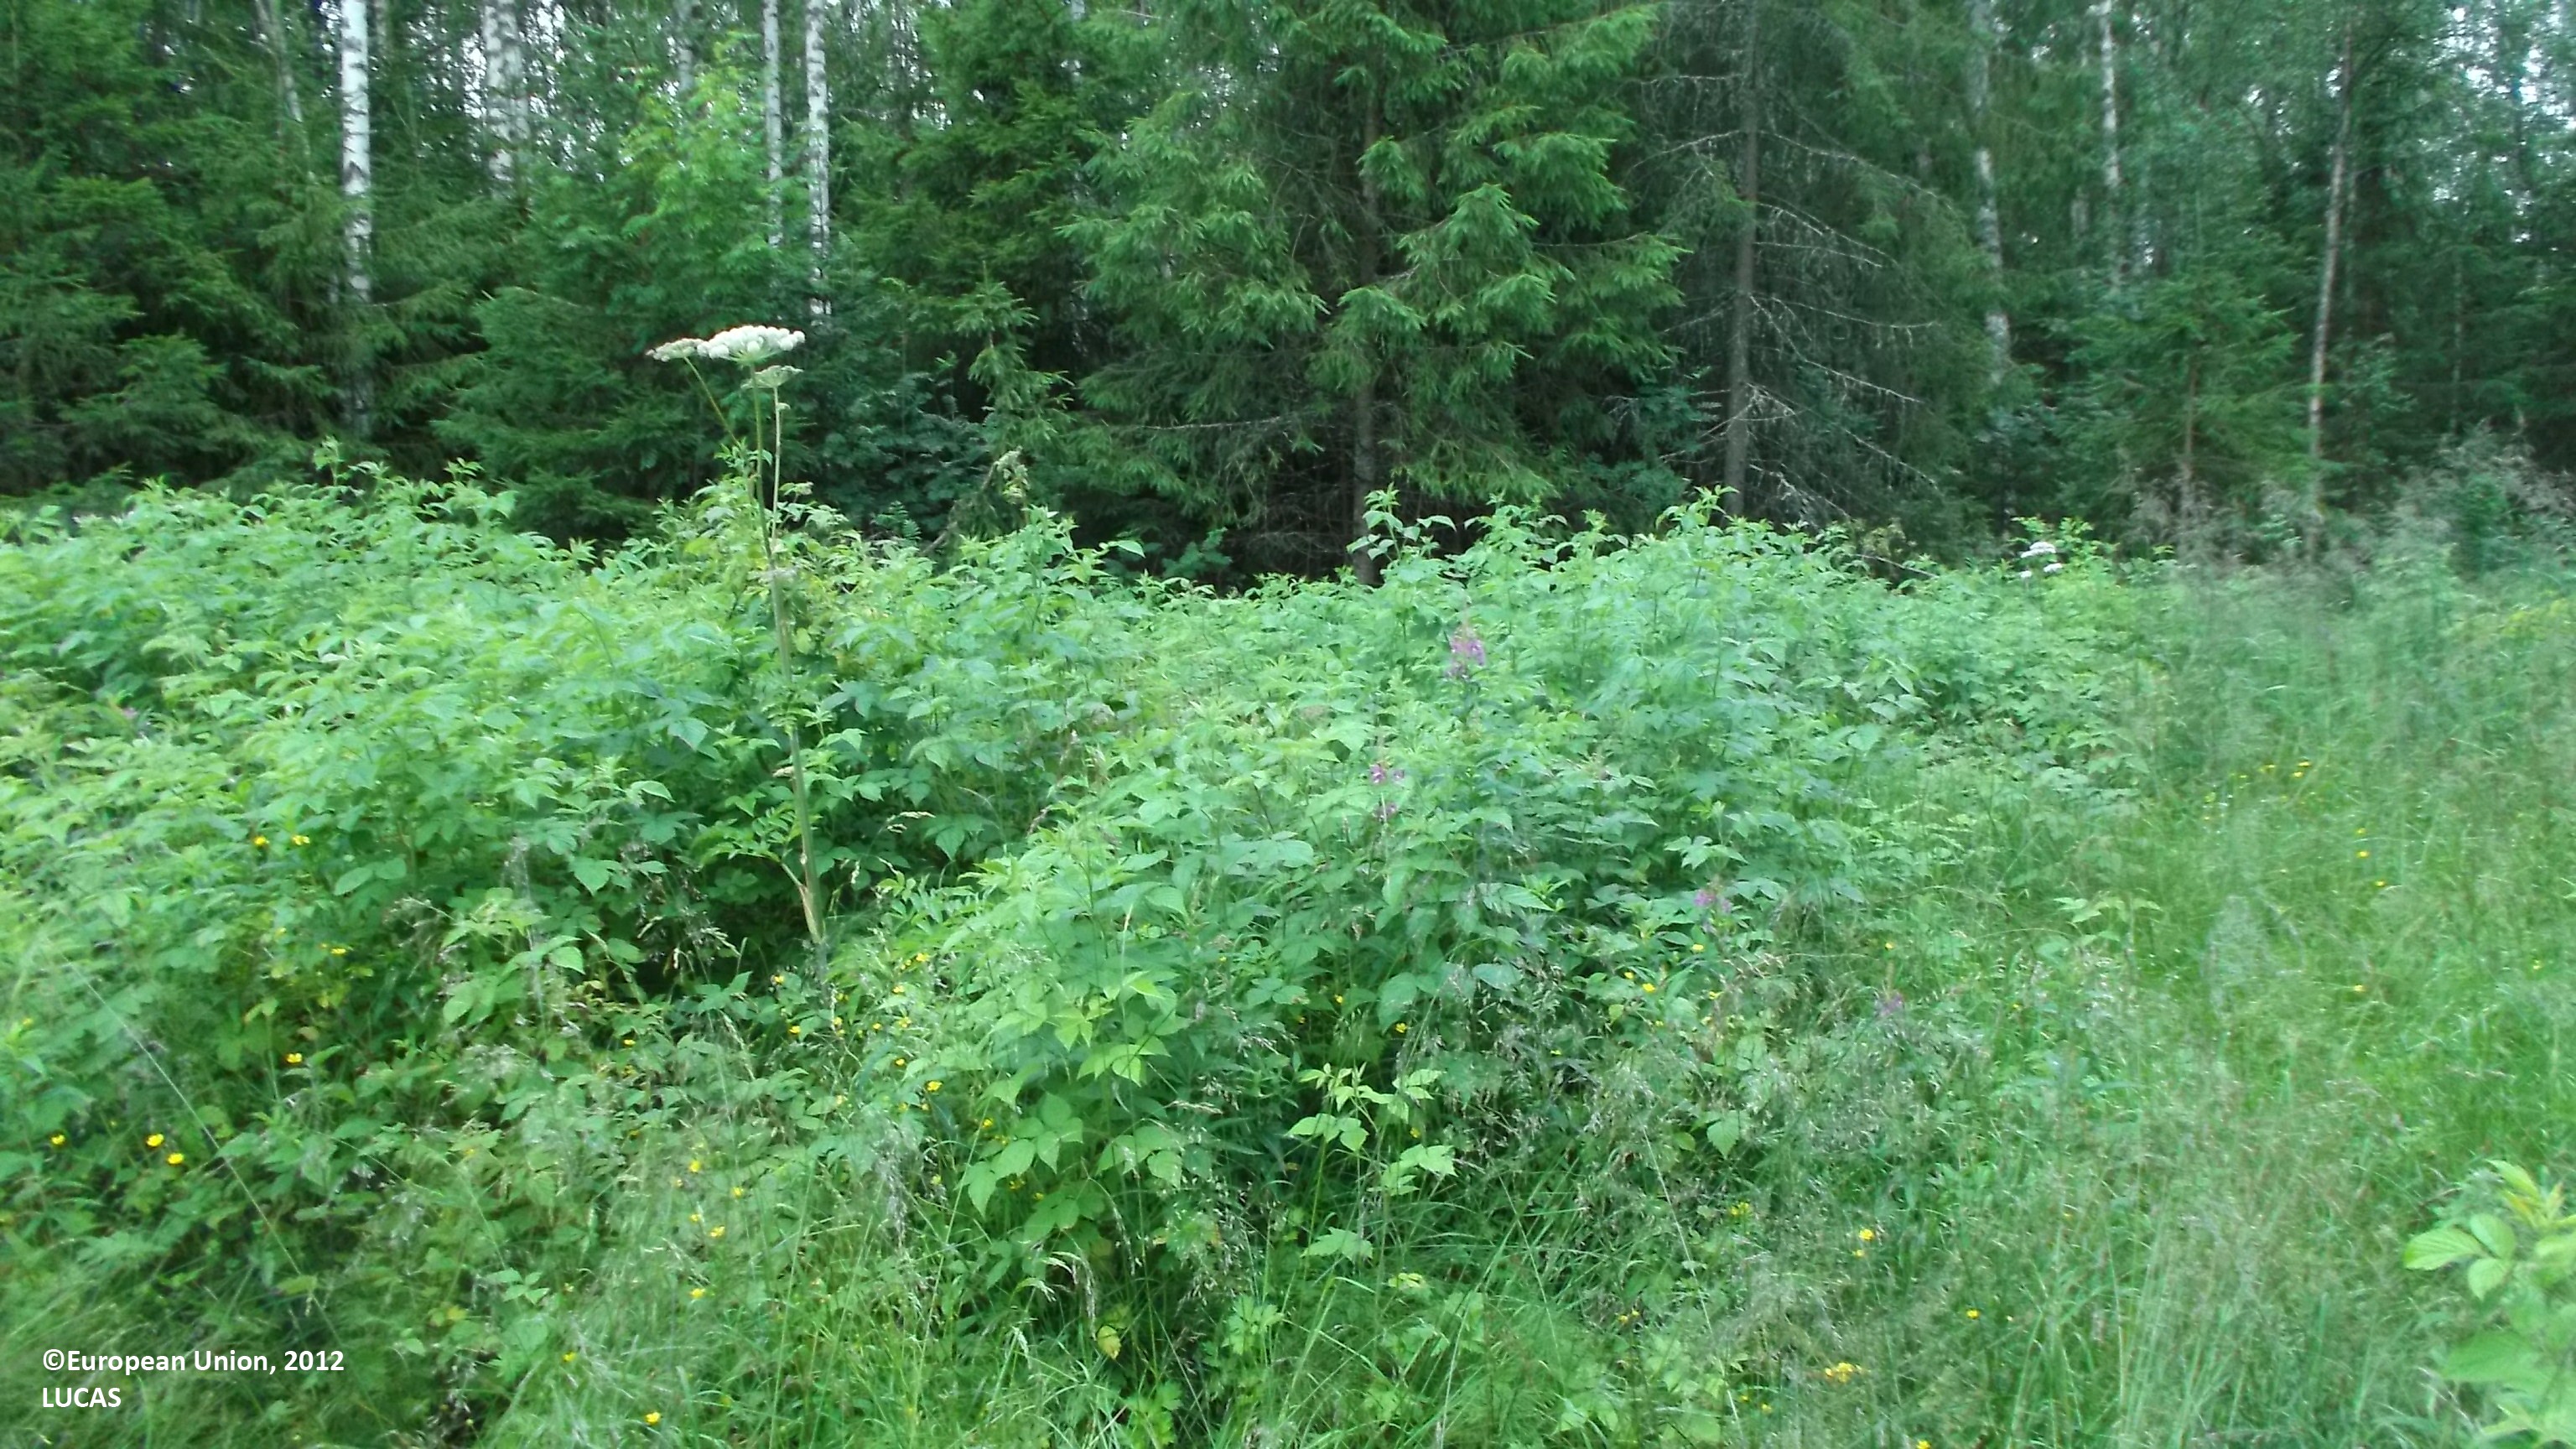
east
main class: Shrubland
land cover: Shrubland with sparse tree cover
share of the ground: > 75 %
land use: Forestry
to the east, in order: Shrubland with sparse tree cover; Spontaneously vegetated surfaces; Other mixed woodland; Ditches and canals; Other mixed woodland; Ditches and canals; Other mixed woodland; Pine dominated mixed woodland; Ditches and canals; Other mixed woodland; Pine dominated mixed woodland; Pine dominated coniferous woodland
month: July
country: FI
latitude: 63.6991
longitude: 23.3889
